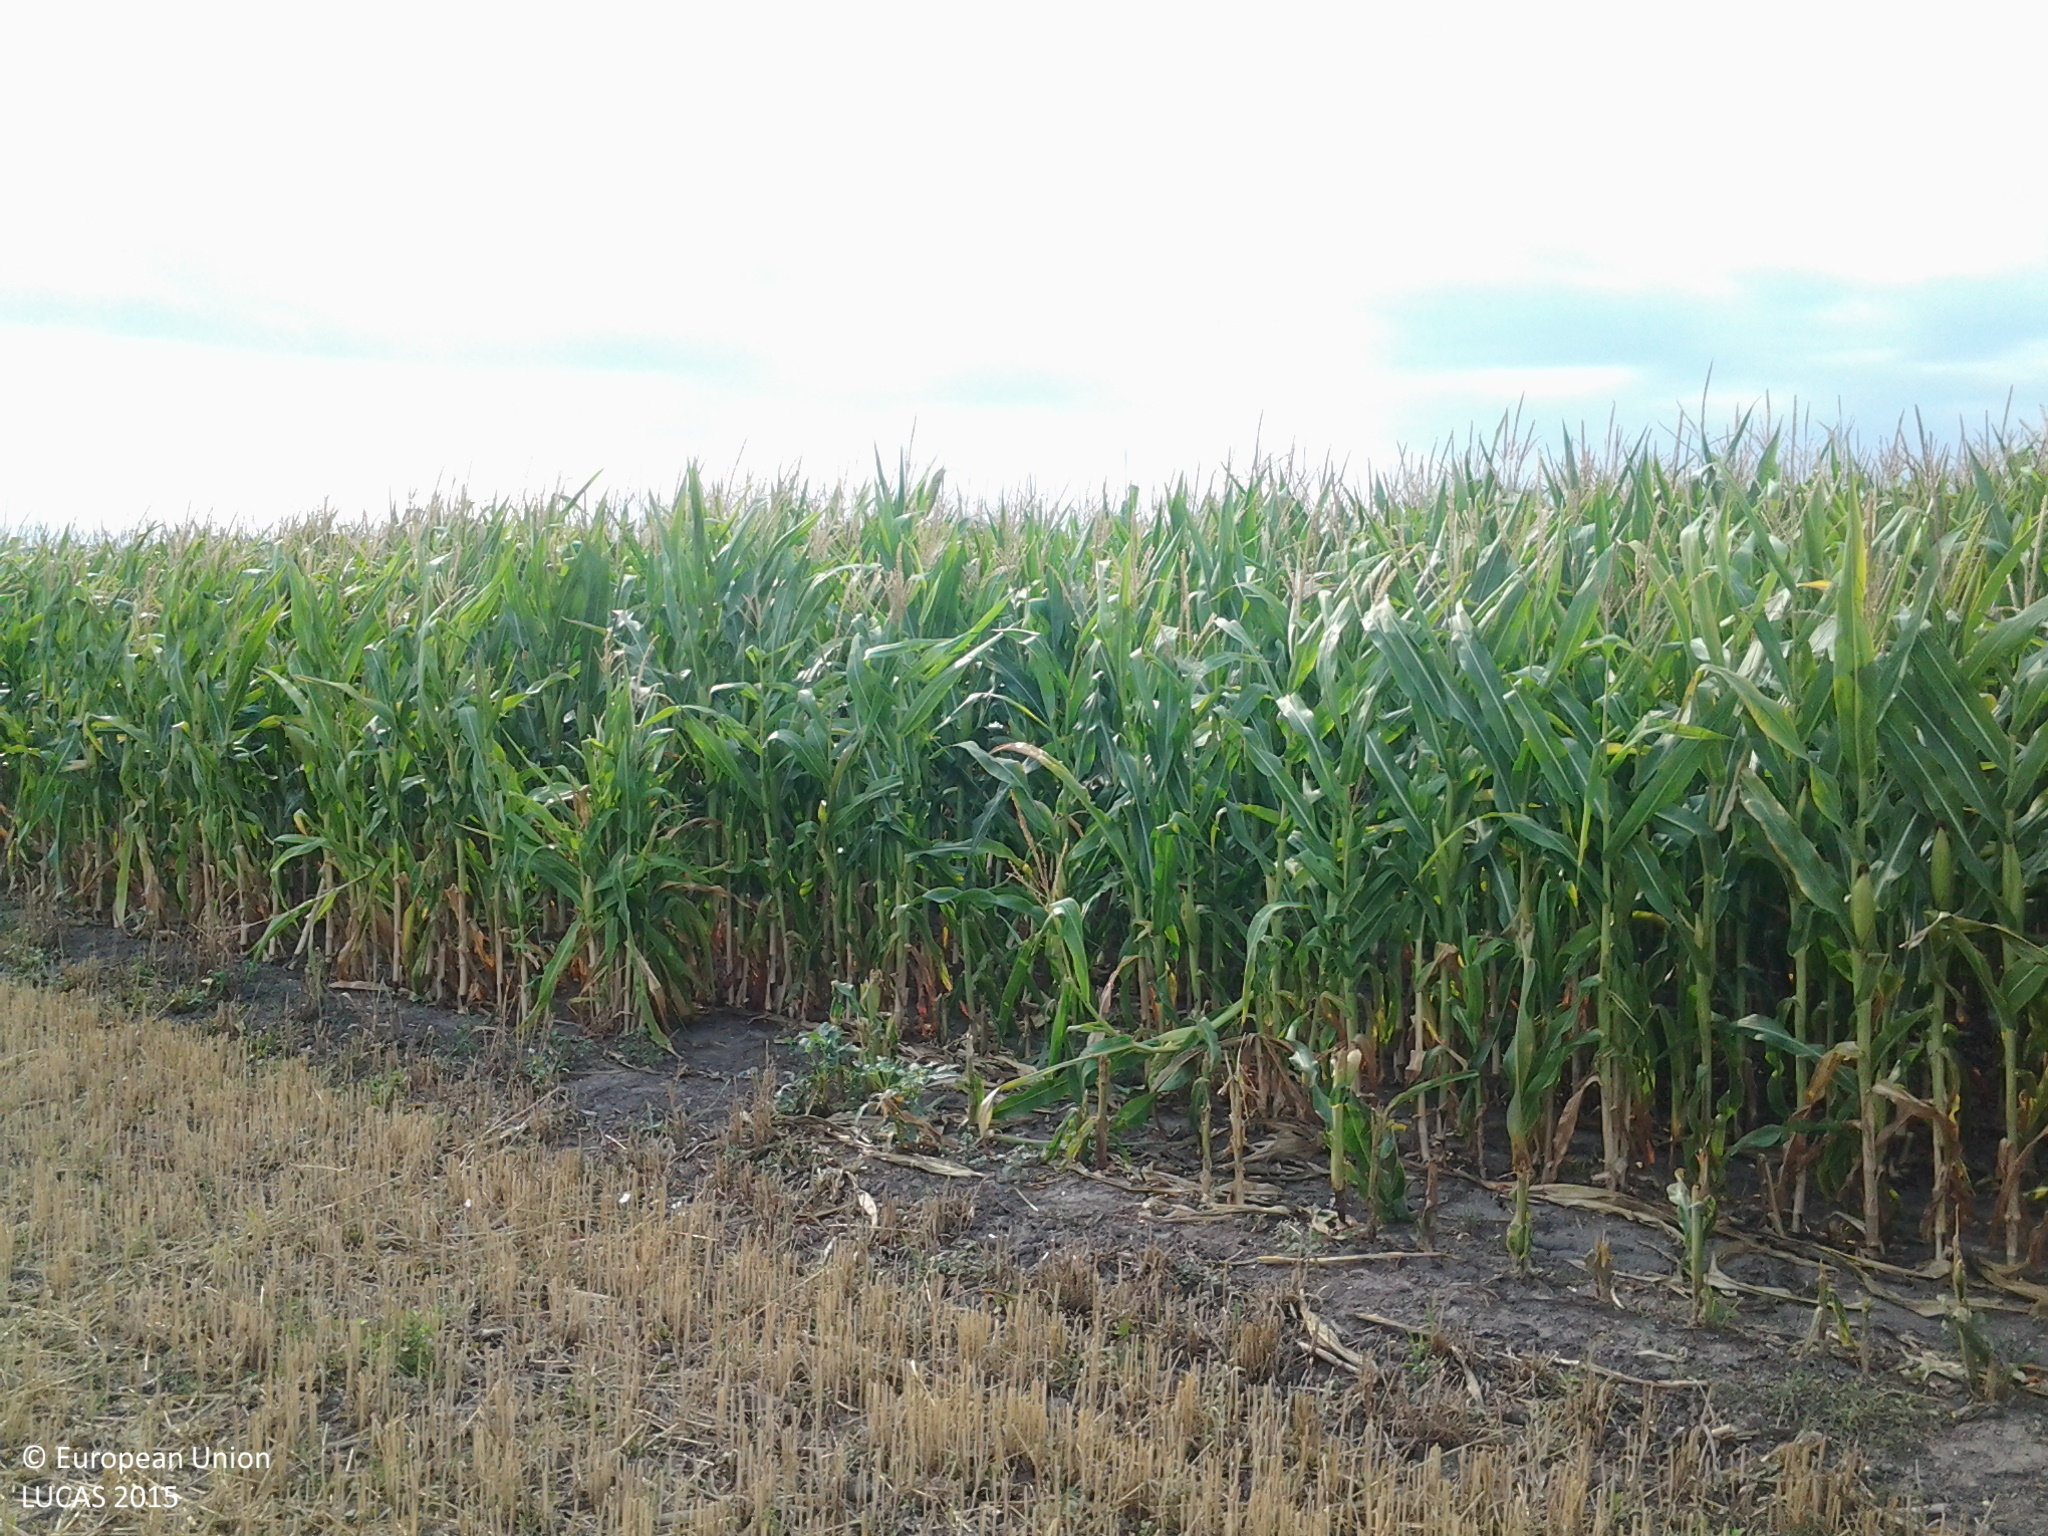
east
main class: Cropland
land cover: Common wheat
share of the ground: 25 - 50 %
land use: Agriculture (excluding fallow land and kitchen gardens)
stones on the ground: < 10 %
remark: Harvested field
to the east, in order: Common wheat; Maize; Tracks; Barley; Broadleaved woodland; Grassland without tree/shrub cover; Common wheat
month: July
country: HU
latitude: 46.9681
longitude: 18.9923
